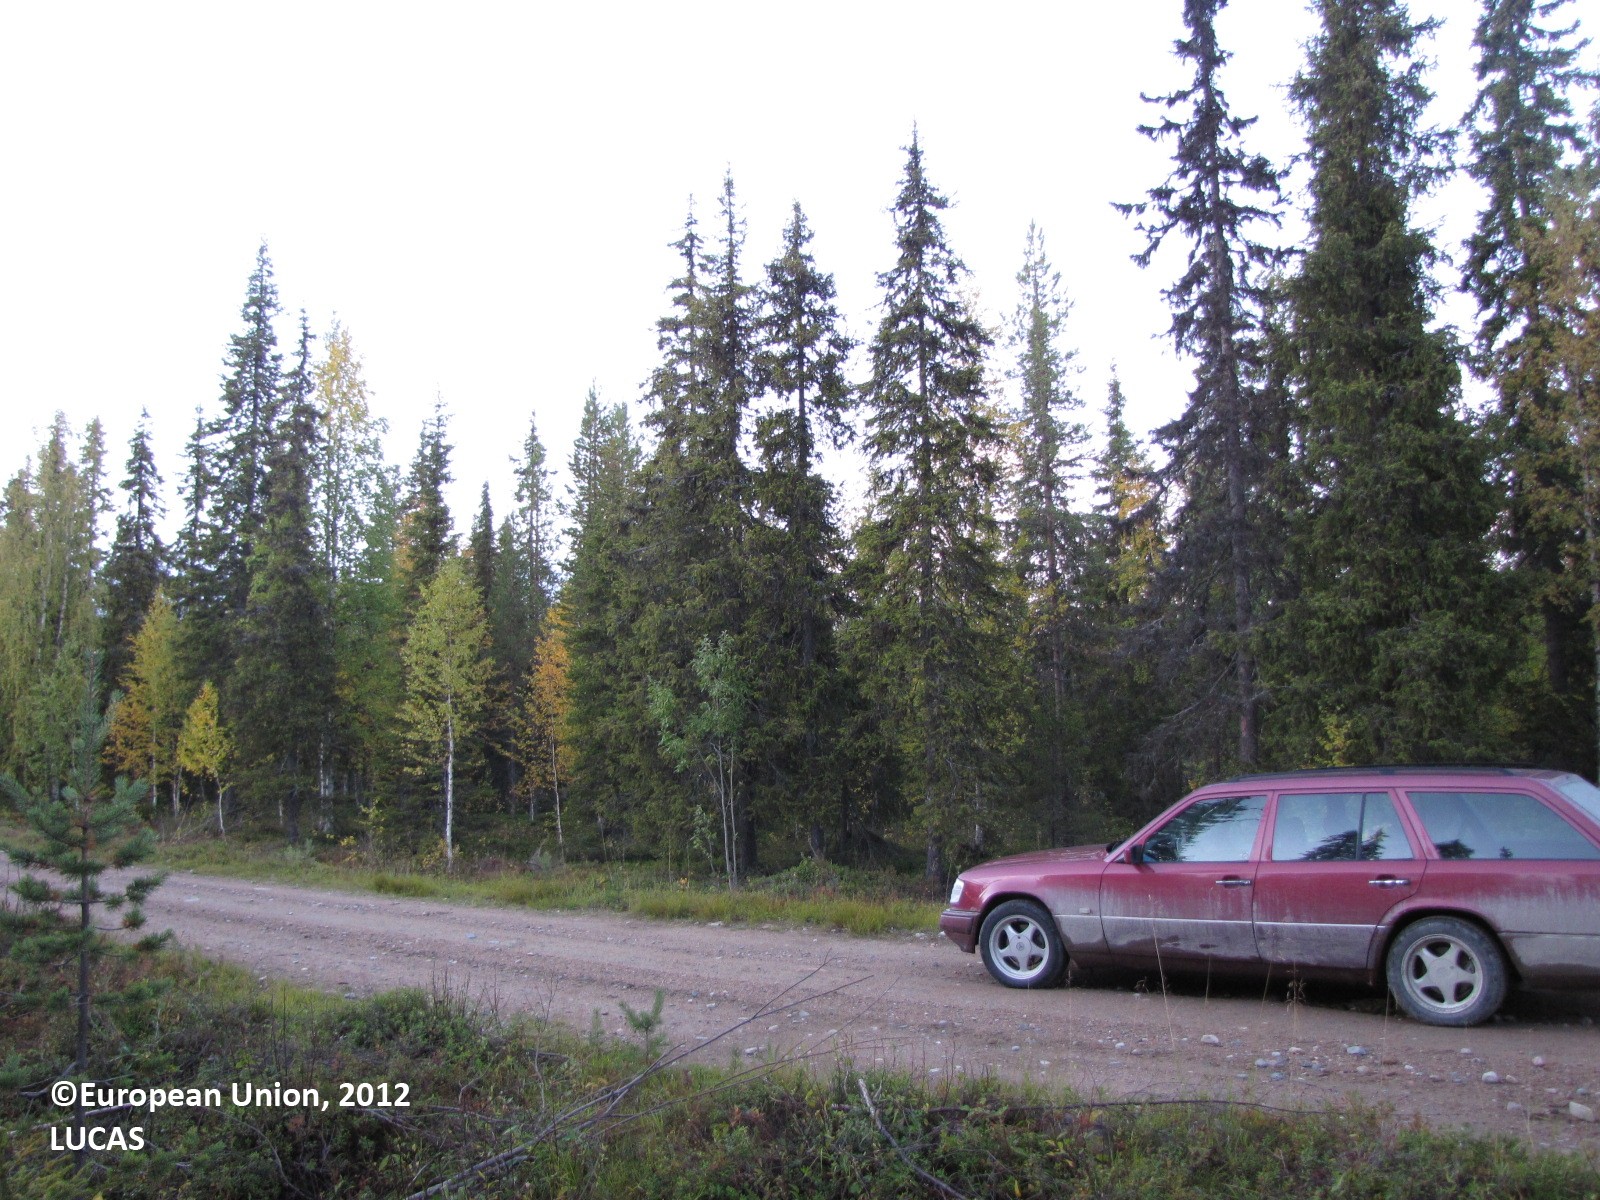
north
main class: Woodland
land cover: Spruce dominated coniferous woodland
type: boreal forest
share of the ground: 25 - 50 %
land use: Forestry
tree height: > 5 m
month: September
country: FI
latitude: 67.3665
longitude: 25.3467
